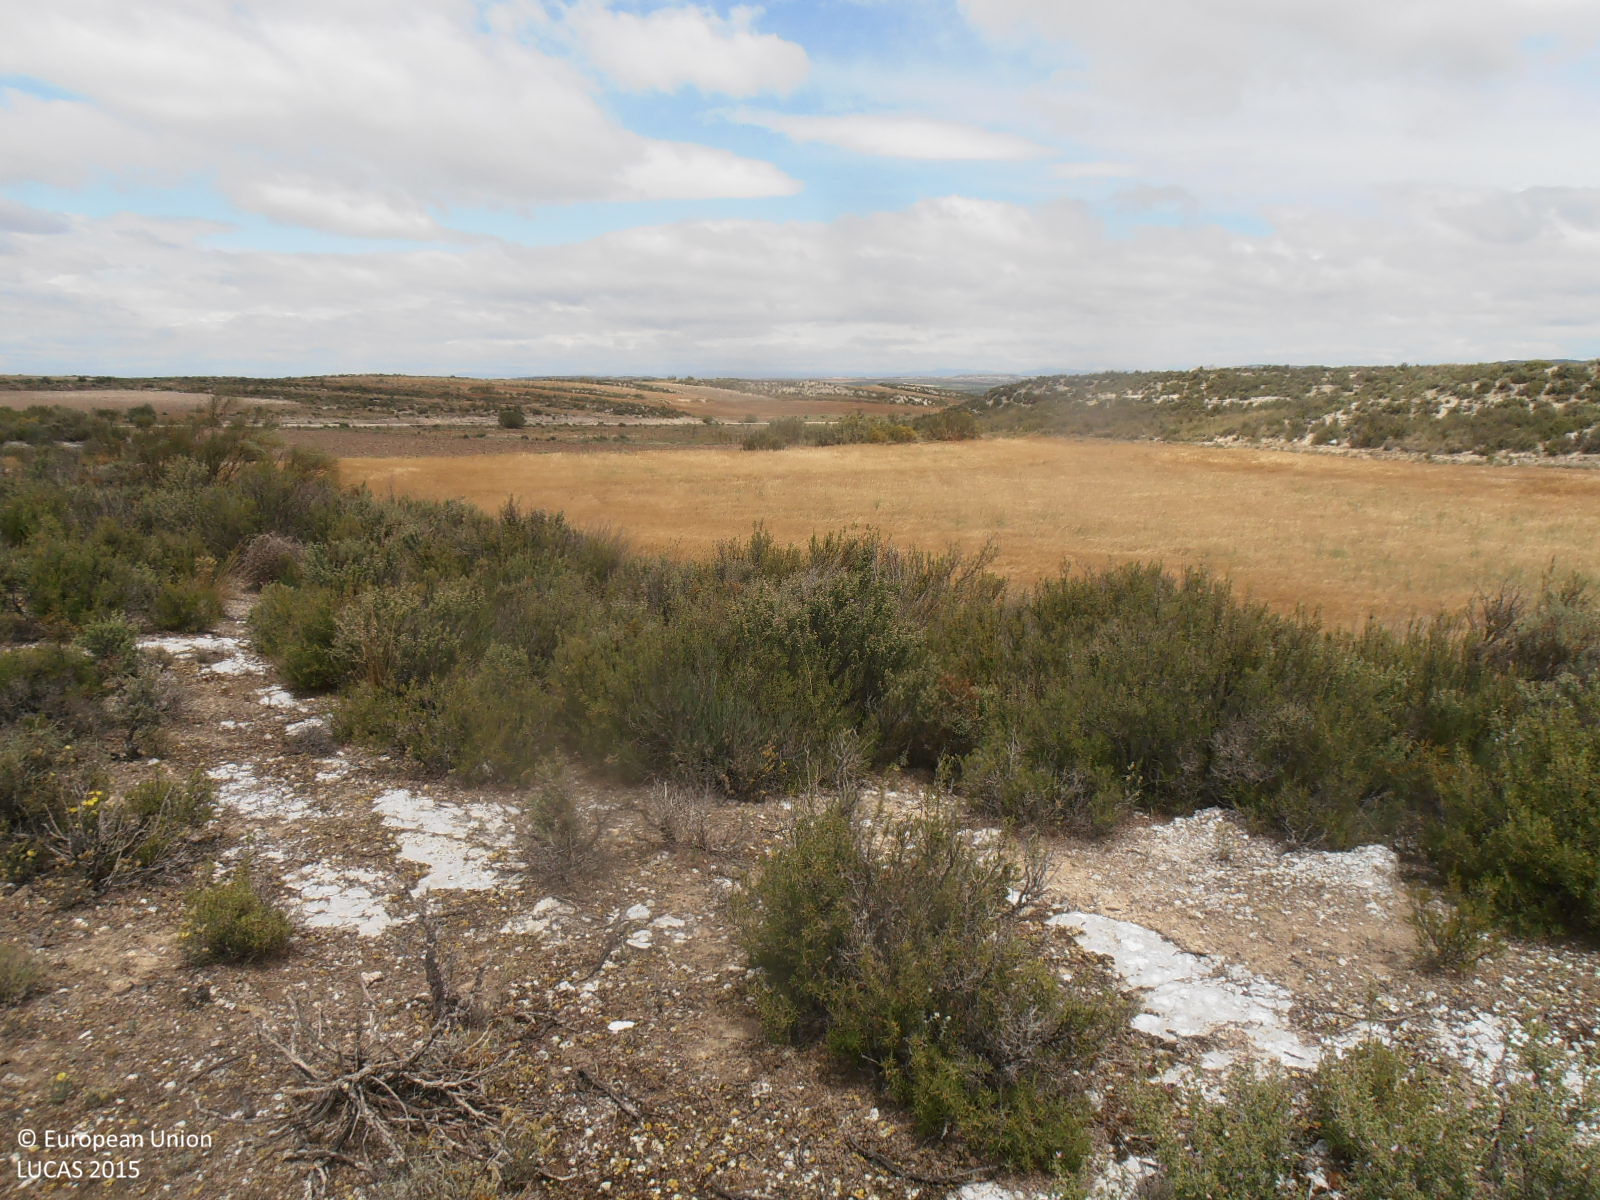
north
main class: Shrubland
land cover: Shrubland without tree cover
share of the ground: 50 - 75 %
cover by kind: shrubs 60 %, consolidated bare surface 40 %
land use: Semi-natural and natural areas not in use
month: June
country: ES
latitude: 41.9317
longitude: -1.1092
